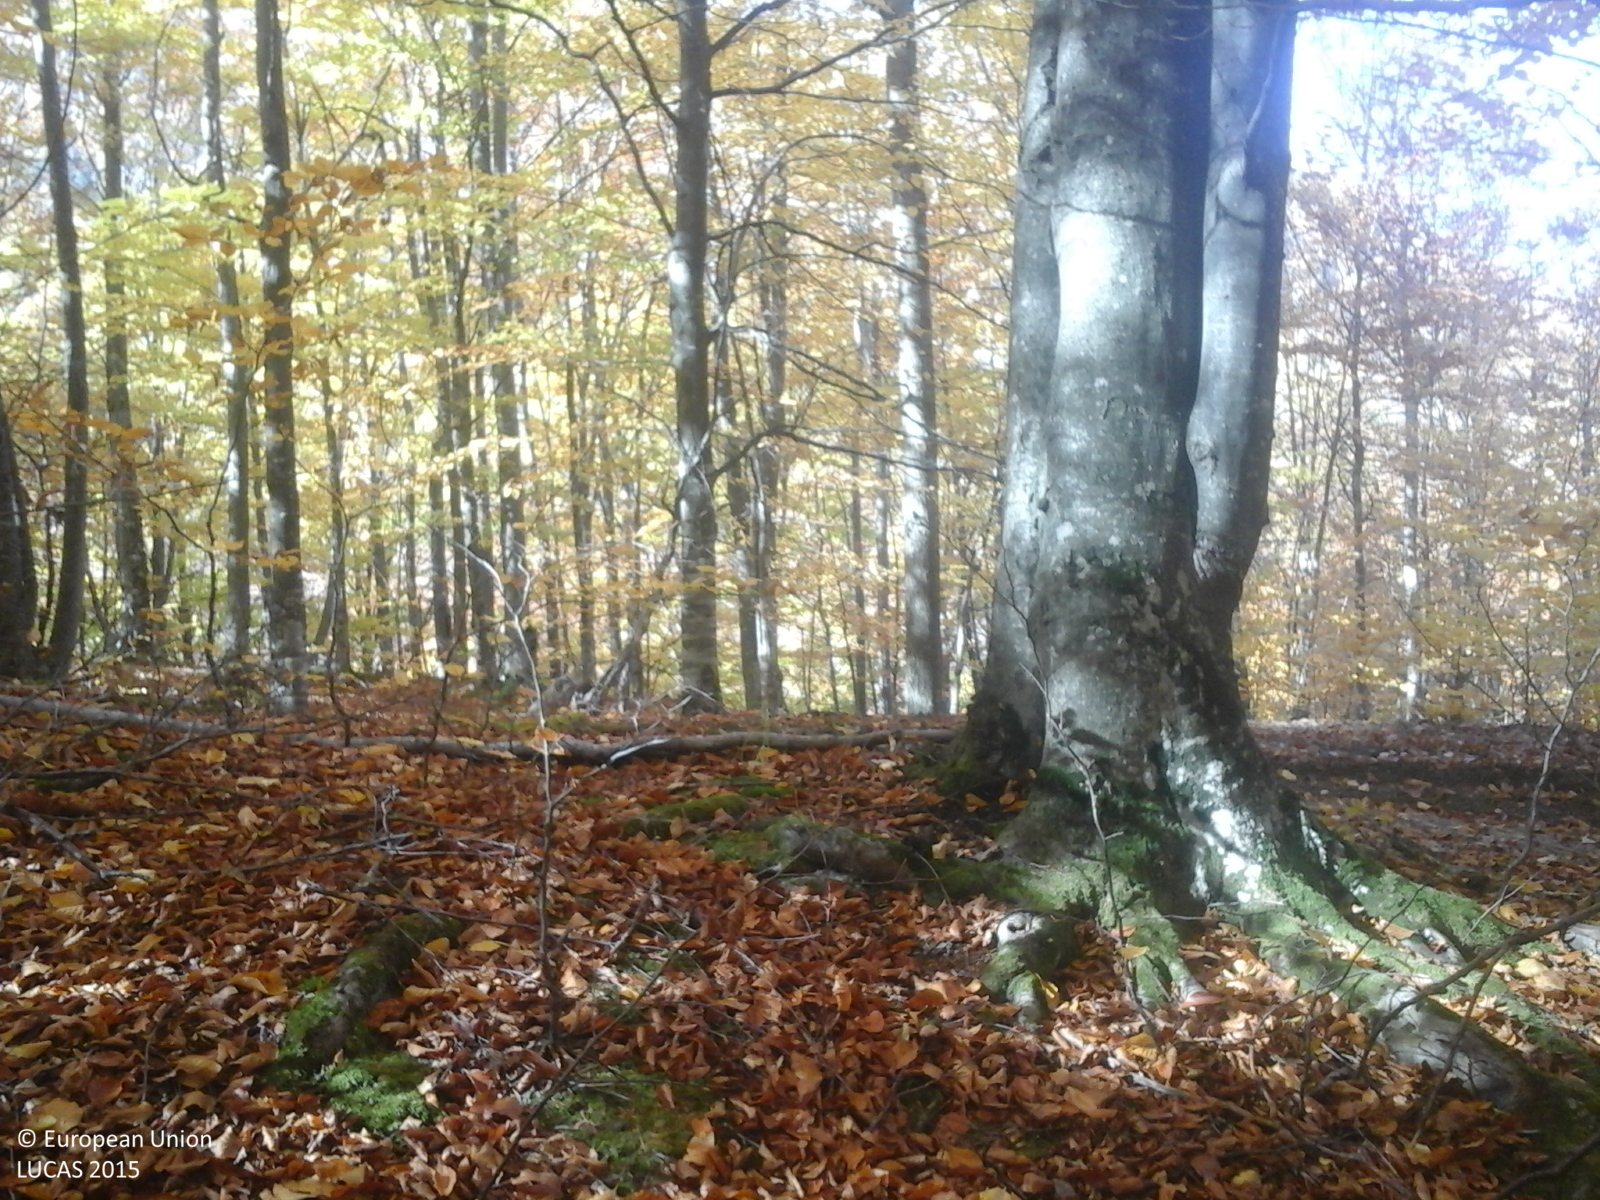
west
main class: Woodland
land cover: Broadleaved woodland
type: beech forest
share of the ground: > 75 %
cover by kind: broadleaved forest trees 100 %
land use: Forestry
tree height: > 5 m
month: October
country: RO
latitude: 45.9246
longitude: 26.5988
